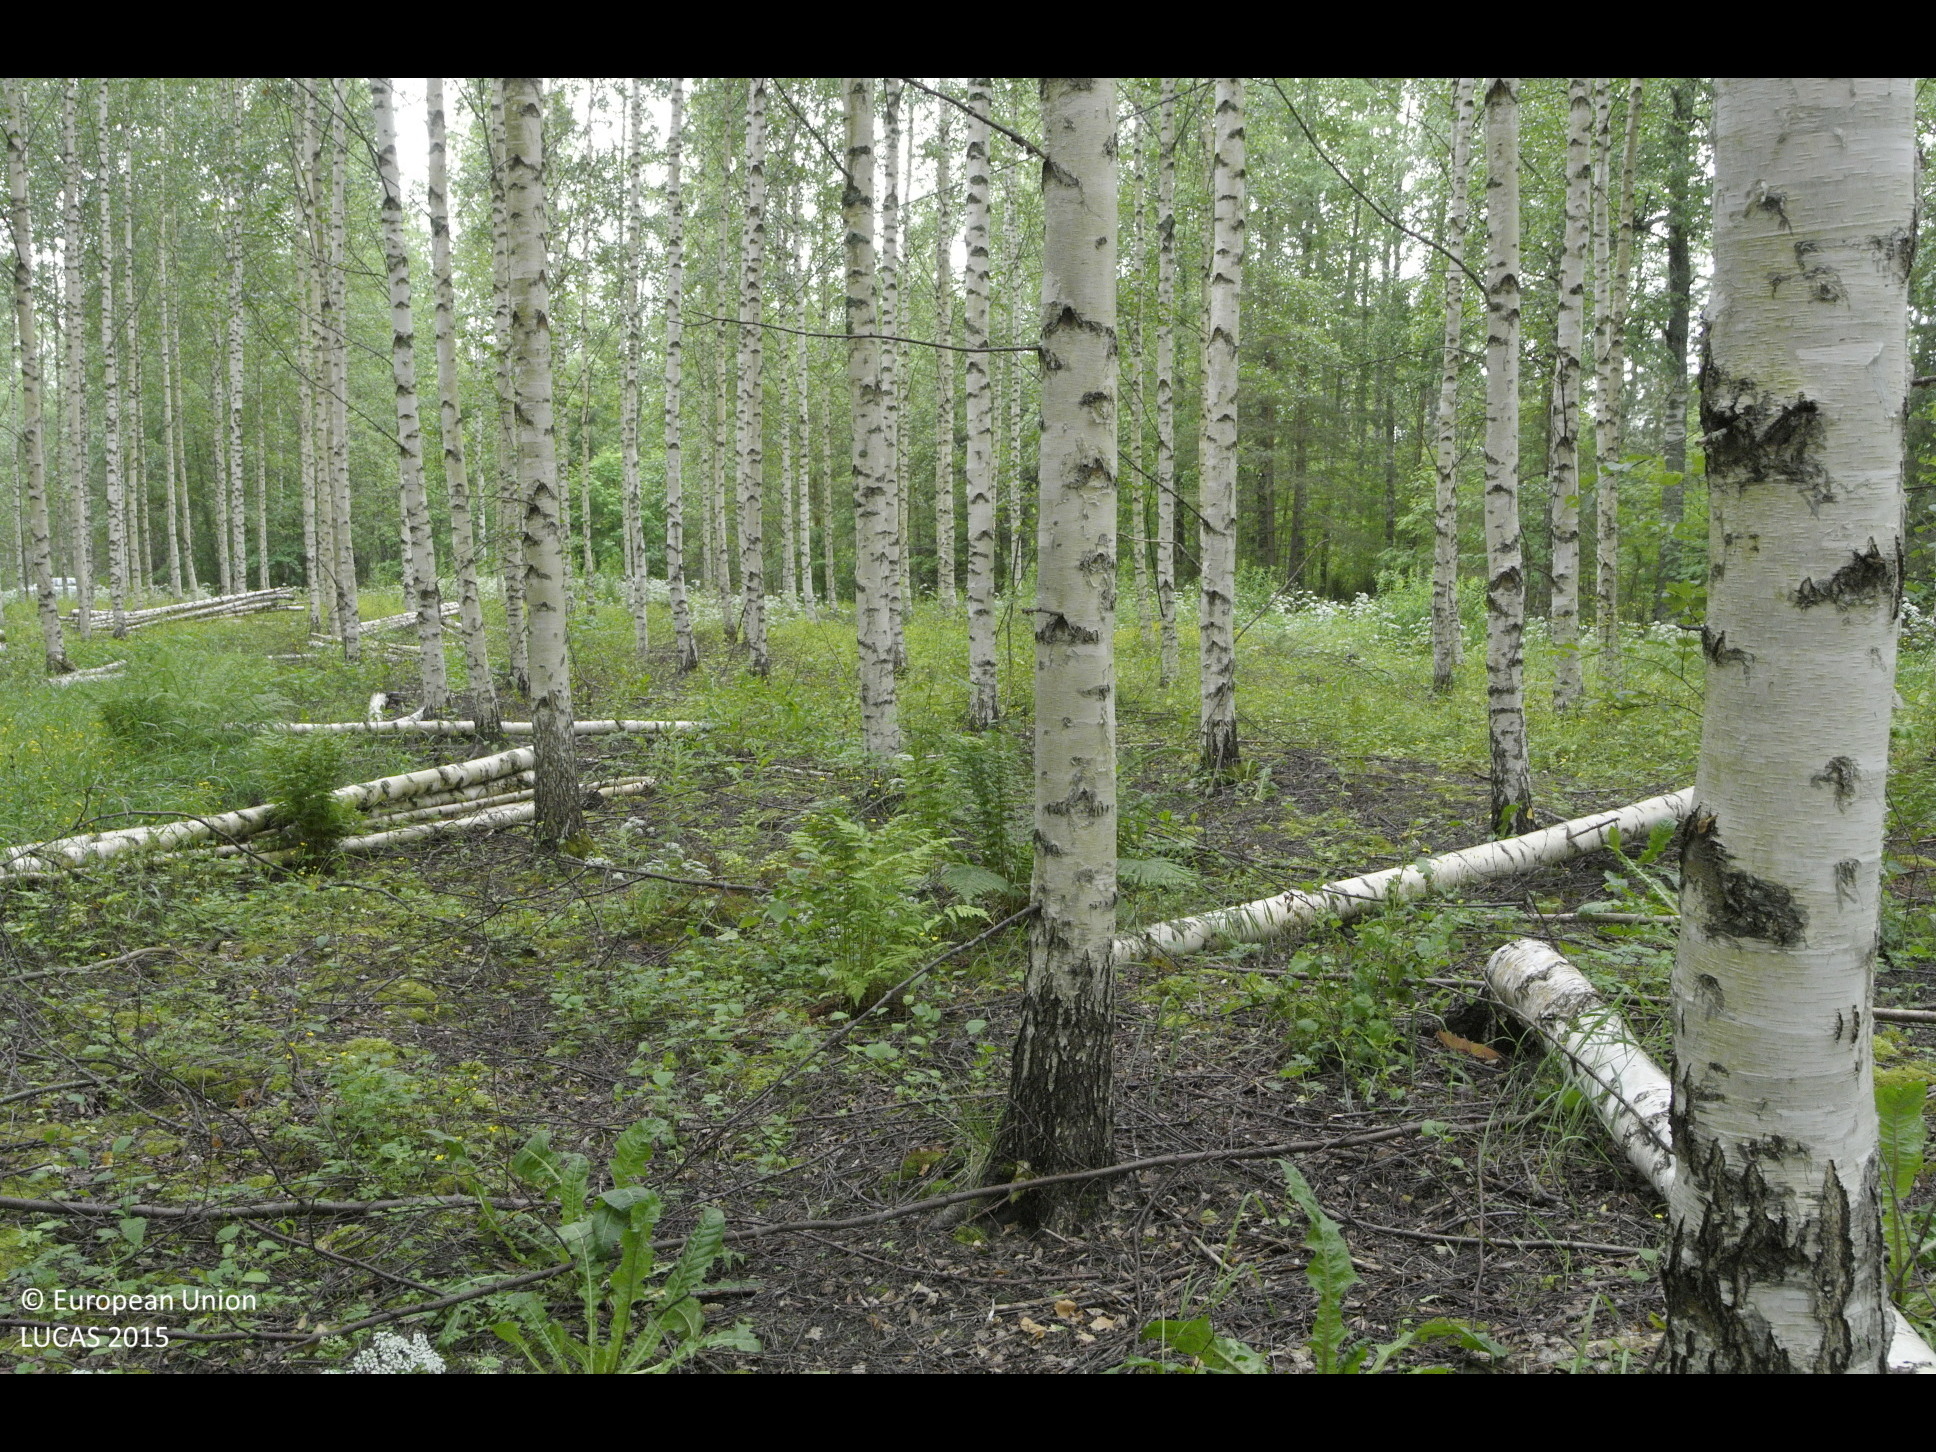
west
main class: Woodland
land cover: Broadleaved woodland
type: non-riverine alder, birch or aspen forest
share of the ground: > 75 %
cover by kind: broadleaved forest trees 85 %, herbaceous plants 15 %
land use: Forestry
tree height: > 5 m
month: July
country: FI
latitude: 61.5483
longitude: 25.8019
